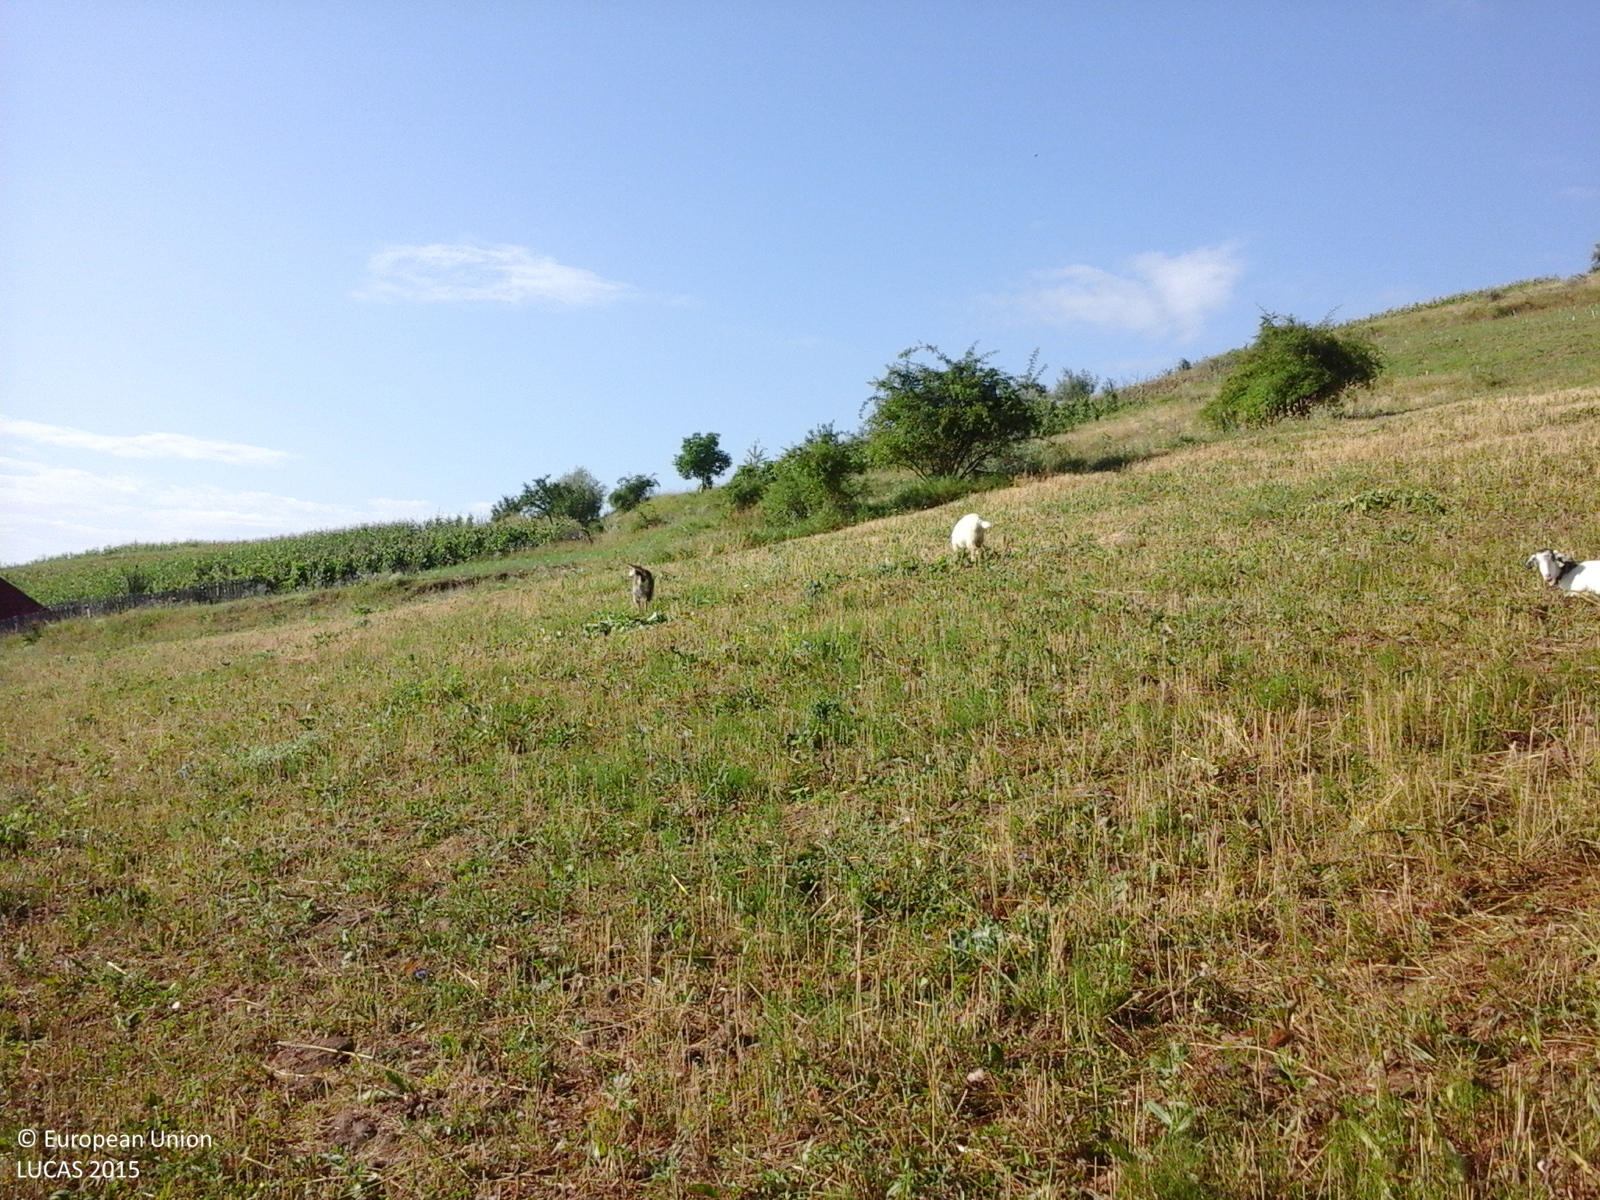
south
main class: Cropland
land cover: Common wheat
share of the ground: 50 - 75 %
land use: Agriculture (excluding fallow land and kitchen gardens)
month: July
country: RO
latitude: 46.5112
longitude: 27.2951
